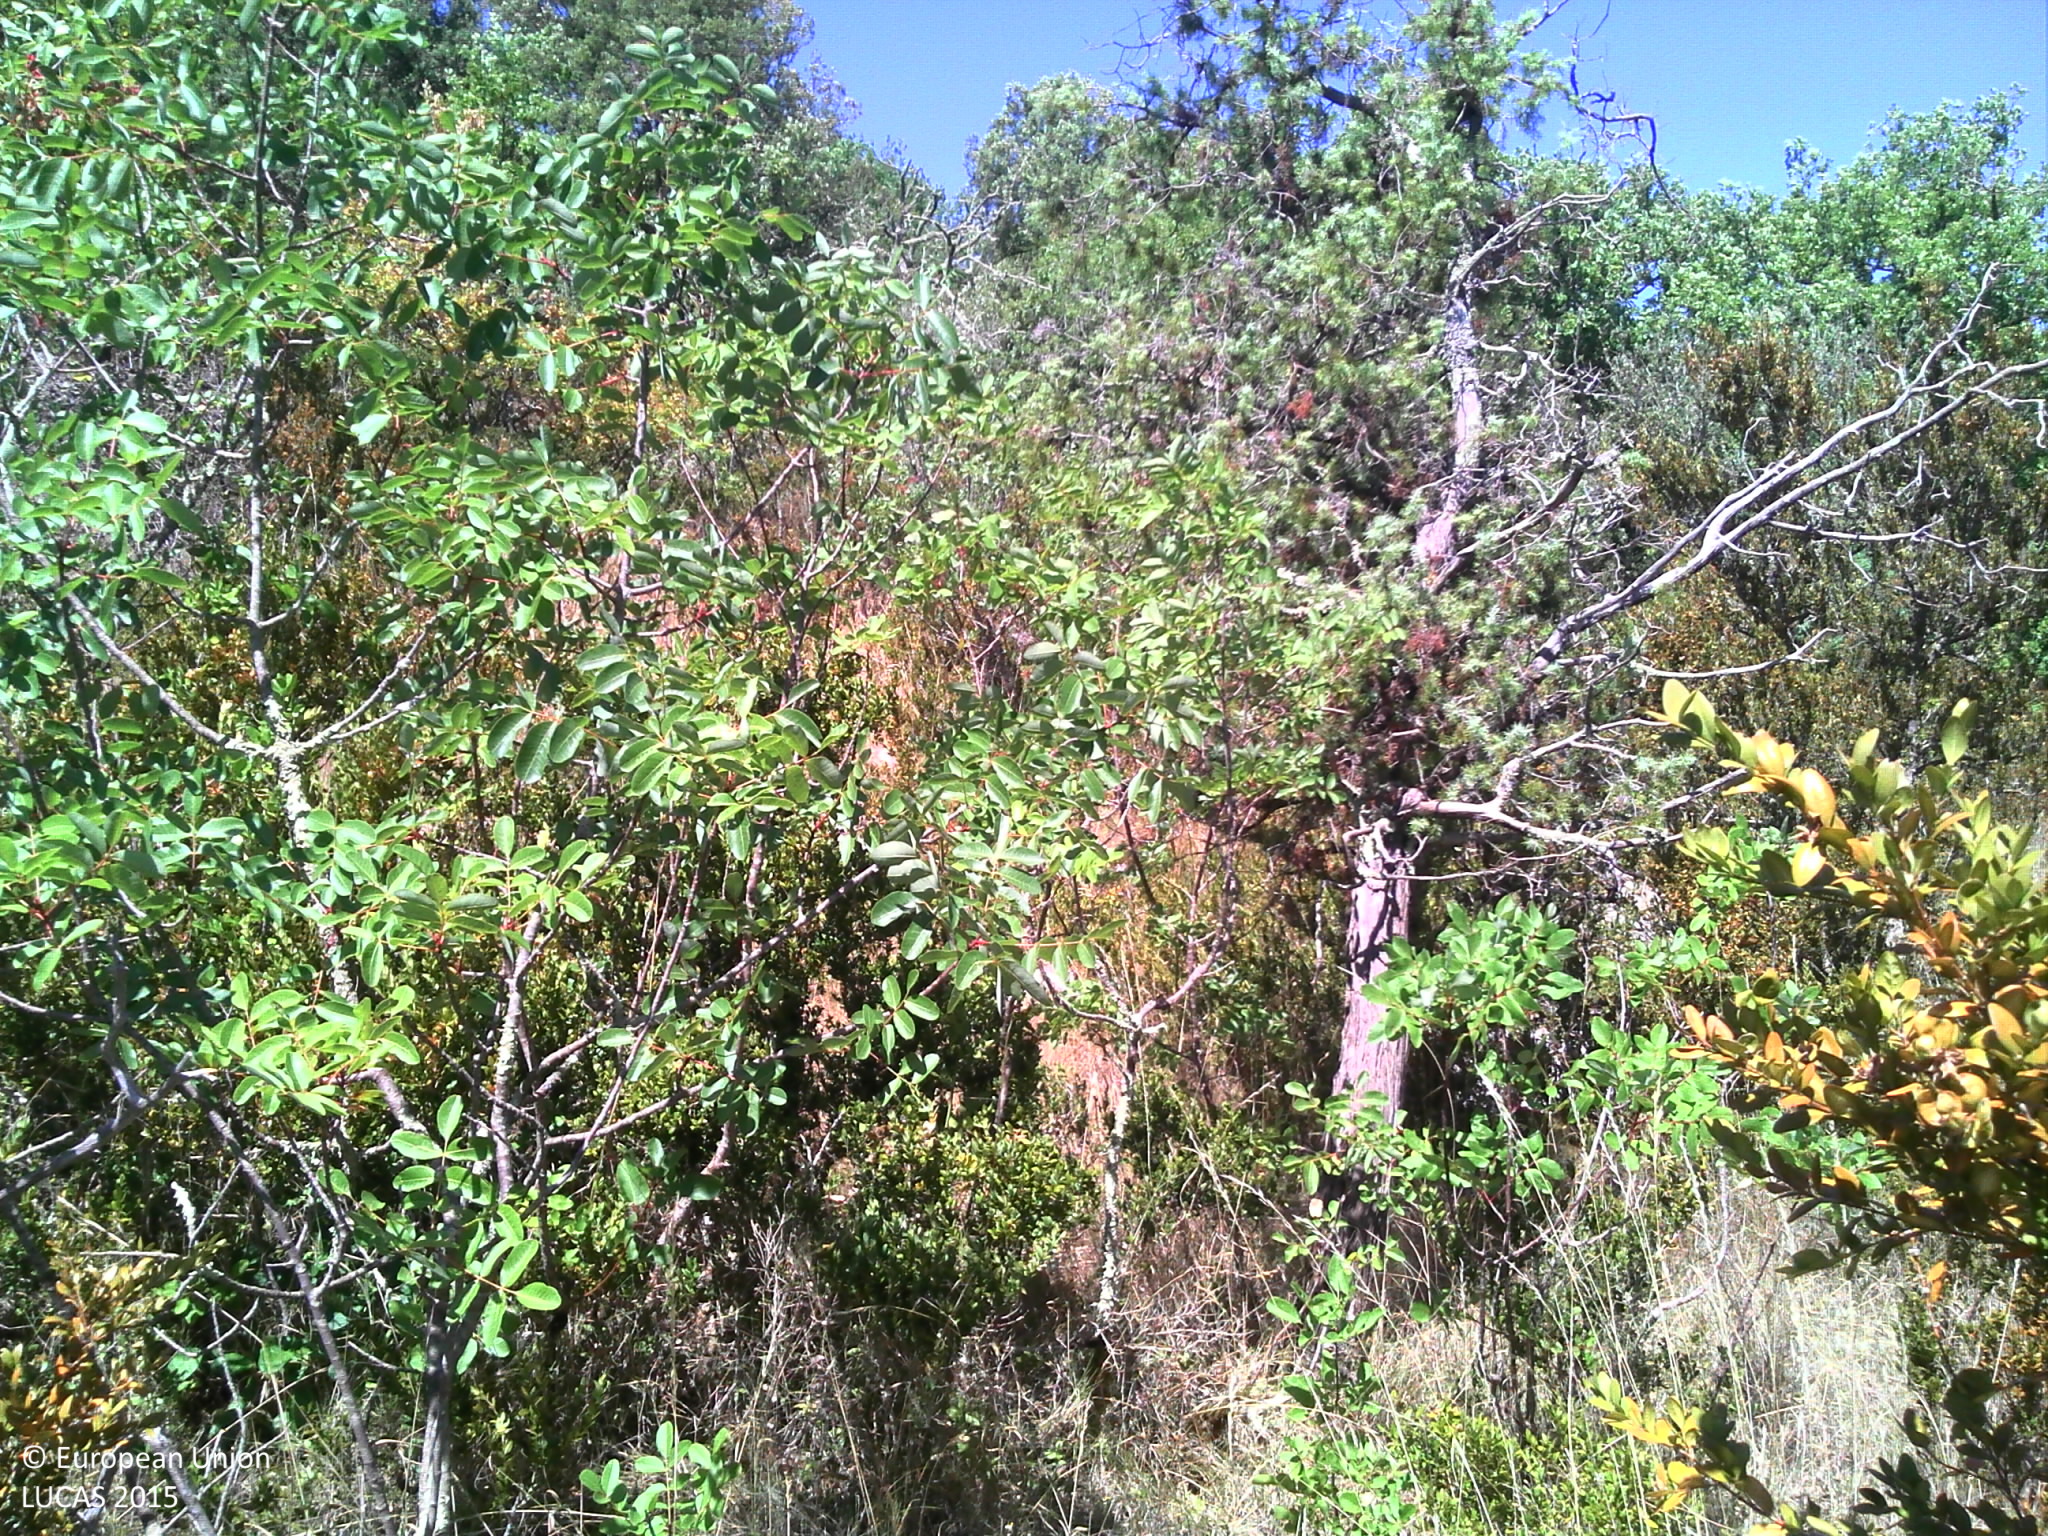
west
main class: Shrubland
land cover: Shrubland with sparse tree cover
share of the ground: > 75 %
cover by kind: shrubs 95 %, broadleaved forest trees 5 %
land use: Semi-natural and natural areas not in use
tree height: > 5 m
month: July
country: FR
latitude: 44.4270
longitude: 4.2662
